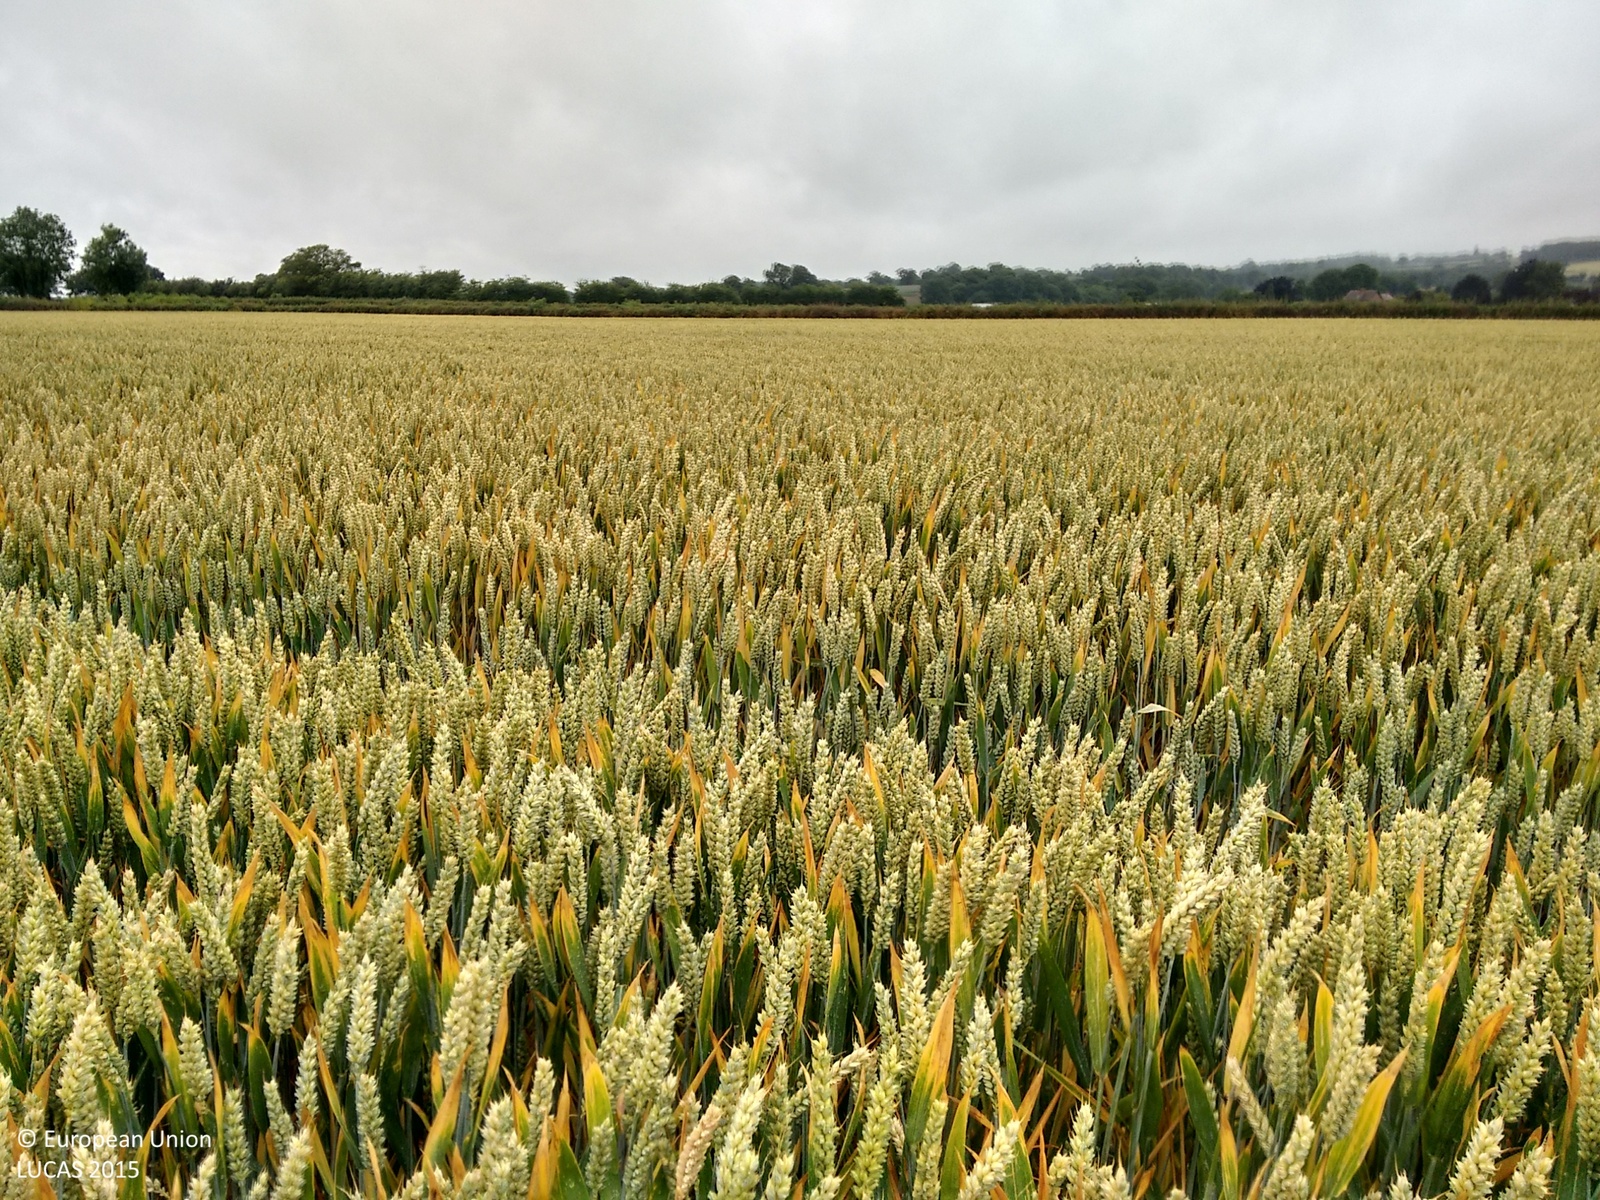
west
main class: Cropland
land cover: Common wheat
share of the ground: > 75 %
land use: Agriculture (excluding fallow land and kitchen gardens)
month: July
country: GB
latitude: 52.2601
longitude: -2.8331
